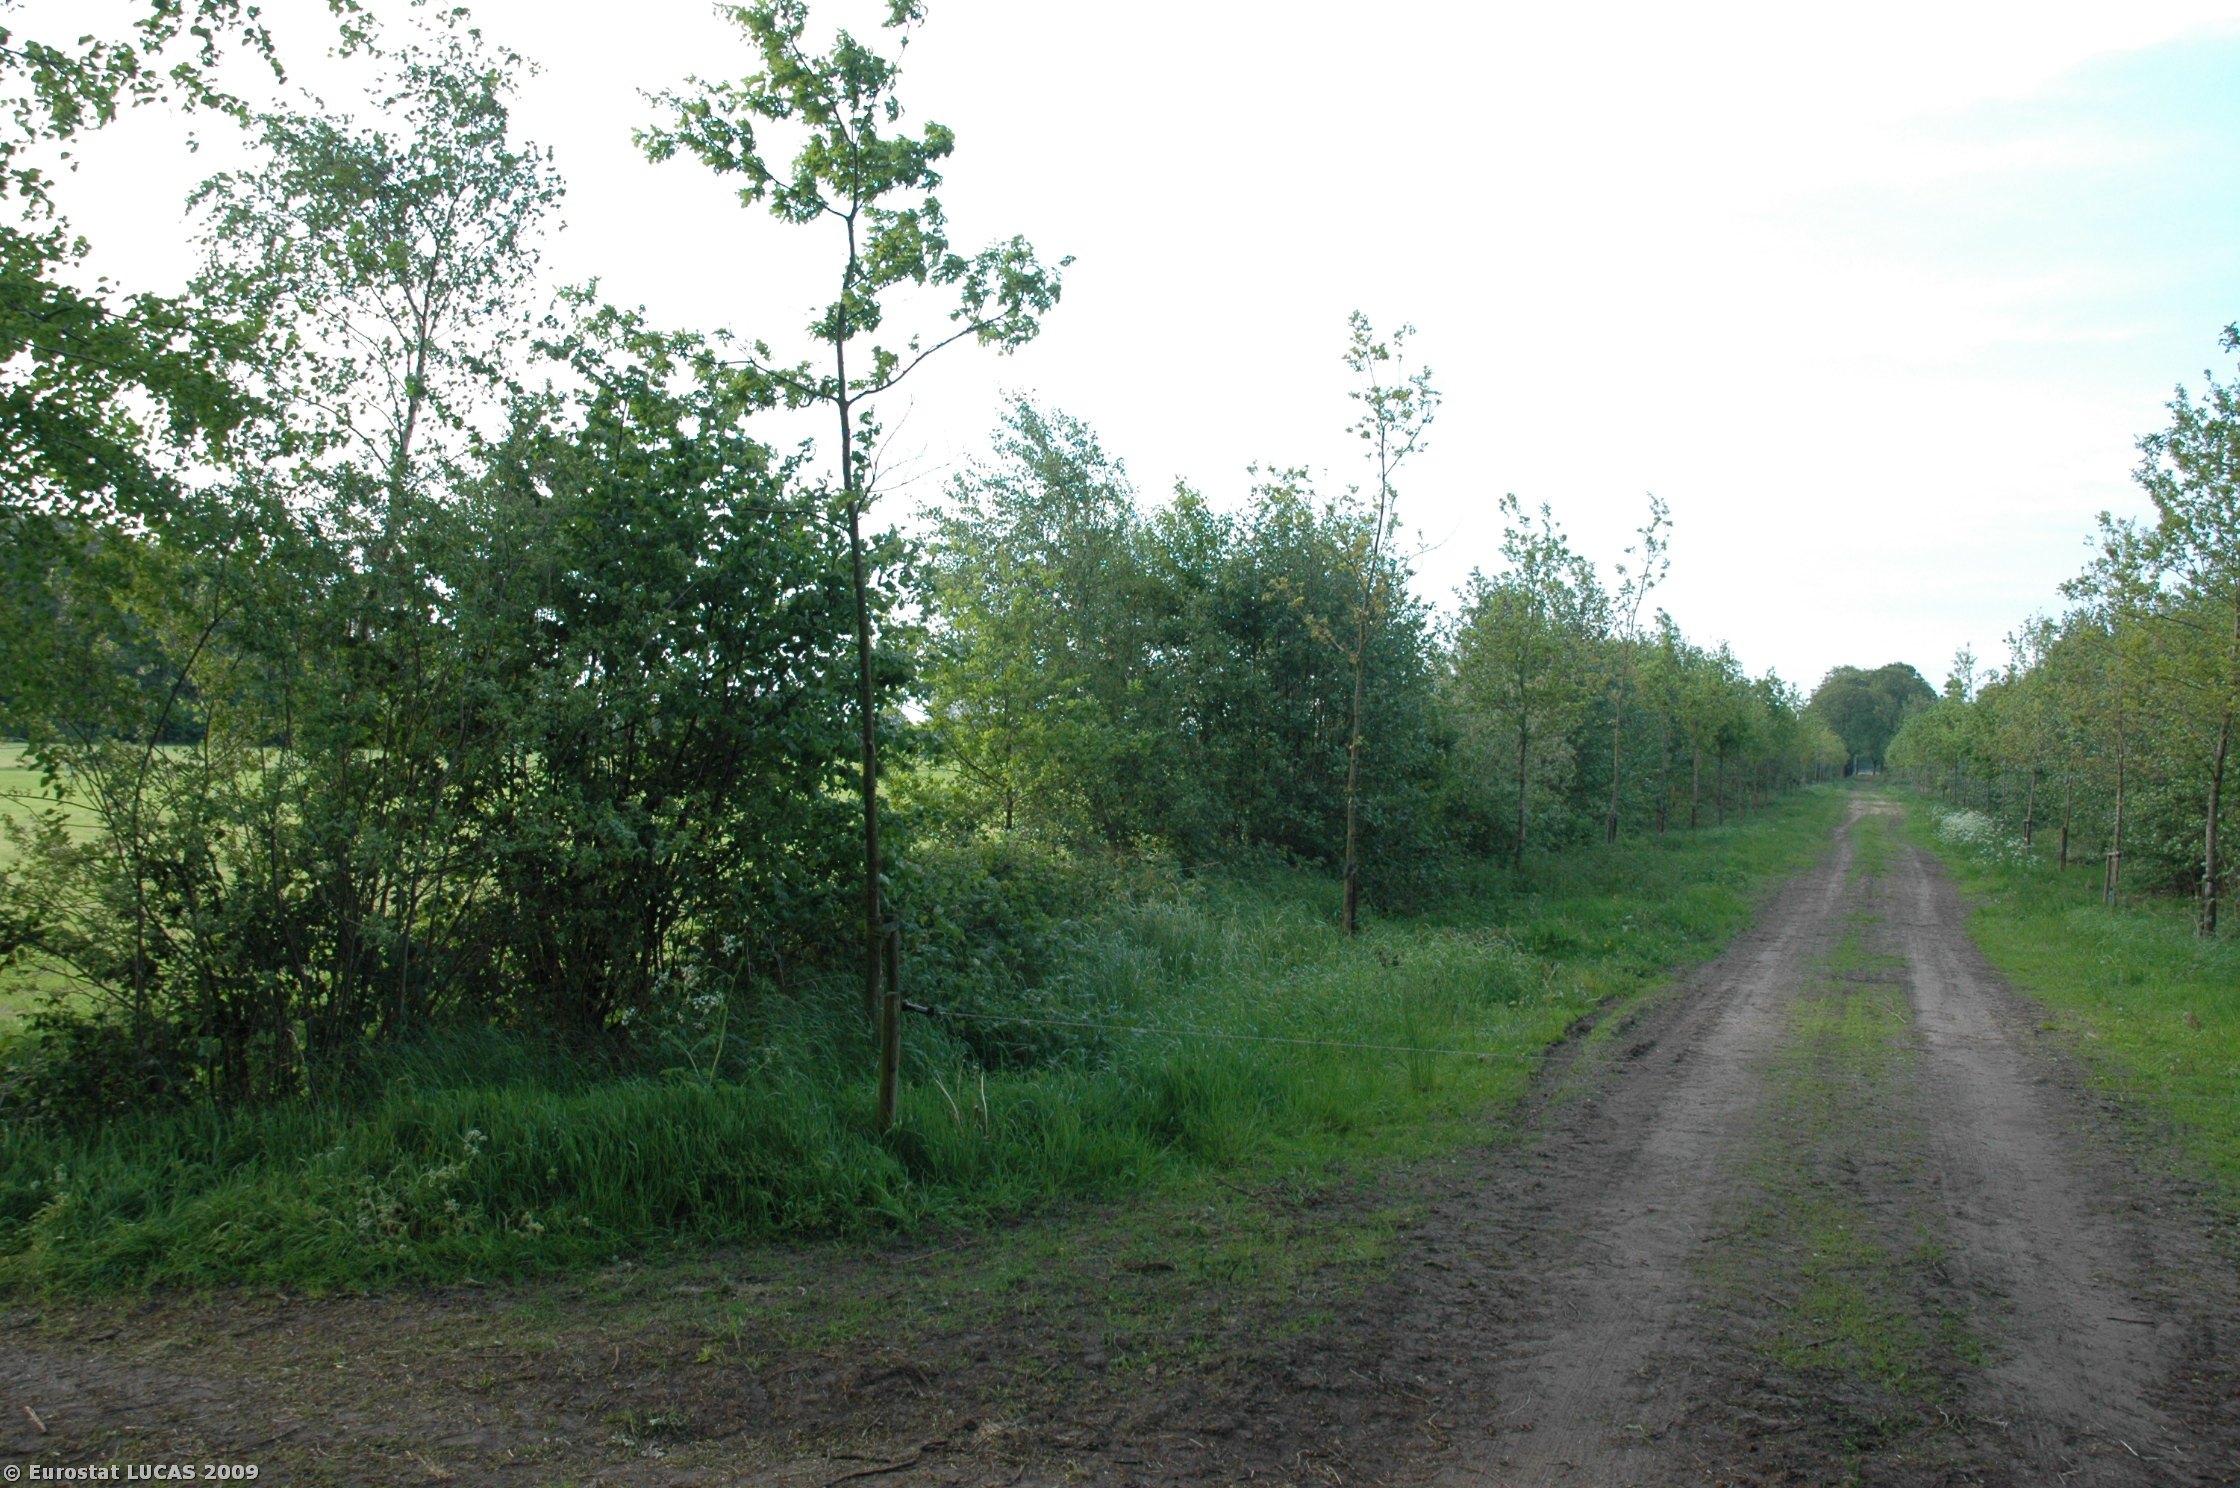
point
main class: Grassland
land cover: Grassland without tree/shrub cover
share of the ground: > 75 %
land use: Agriculture (excluding fallow land and kitchen gardens)
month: May
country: NL
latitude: 52.0556
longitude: 5.4334
